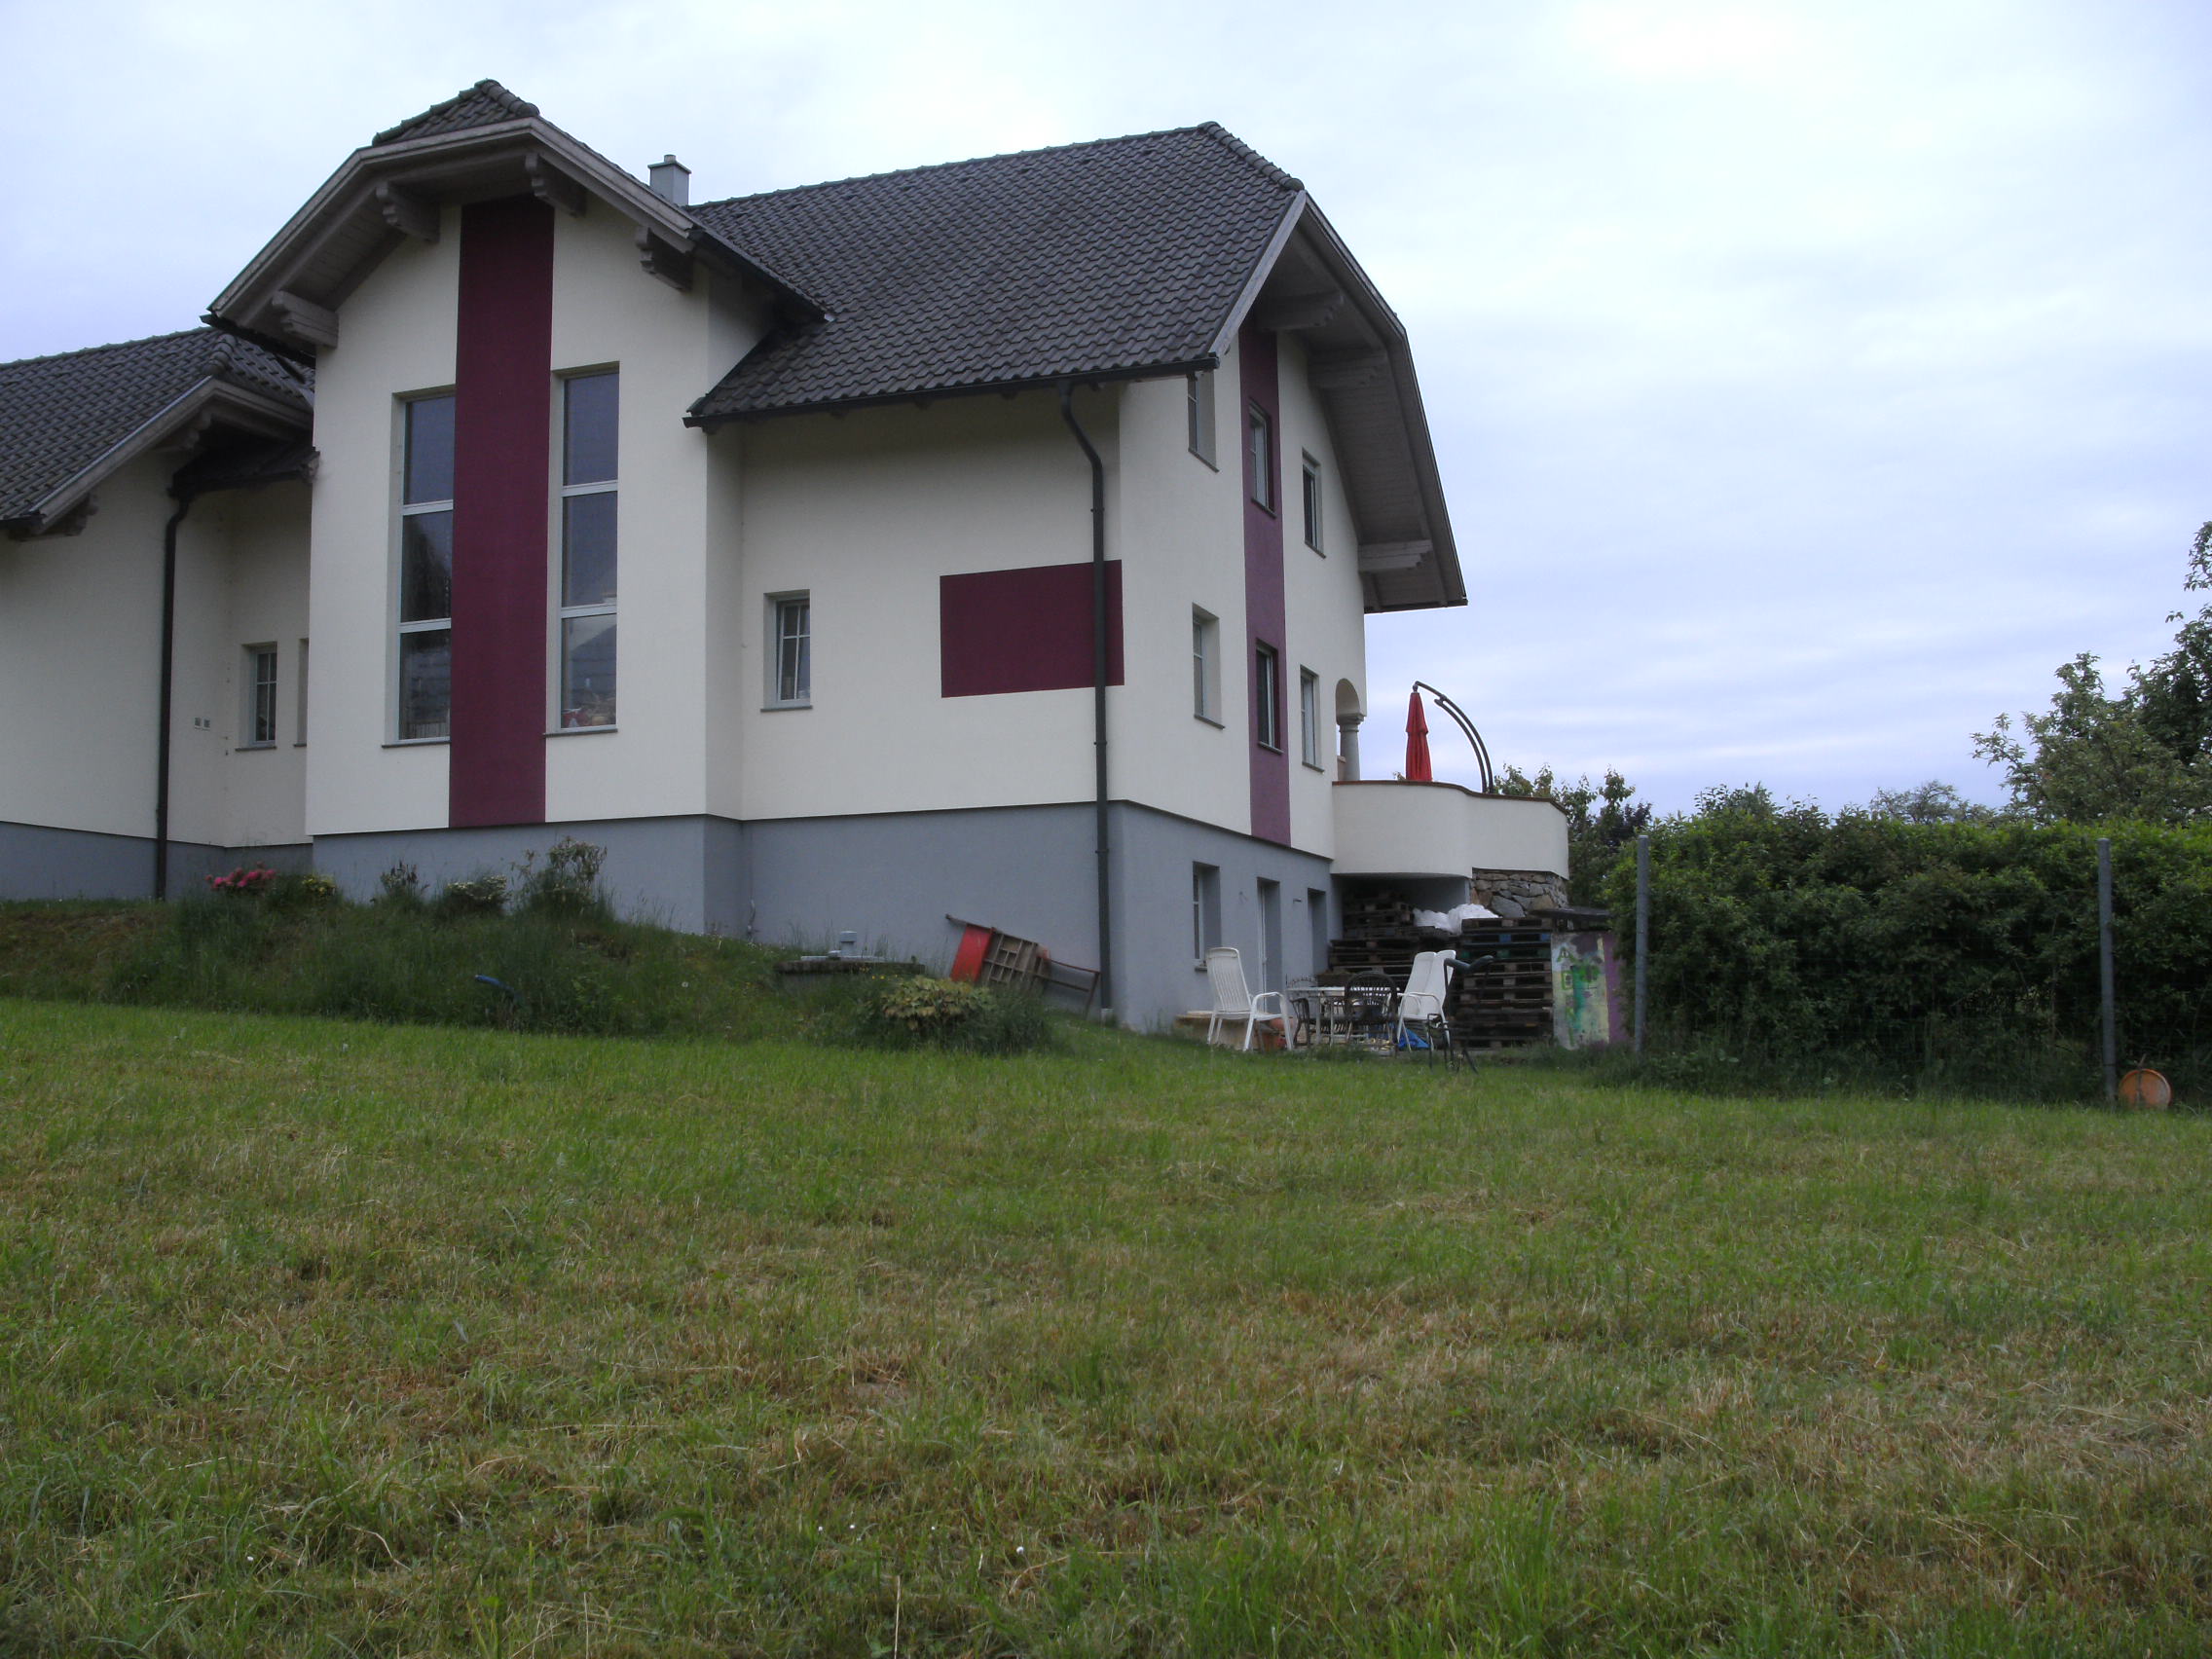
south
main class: Grassland
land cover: Grassland without tree/shrub cover
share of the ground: > 75 %
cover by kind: herbaceous plants 100 %
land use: Agriculture (excluding fallow land and kitchen gardens)
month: May
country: AT
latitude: 48.3680
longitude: 13.4415
